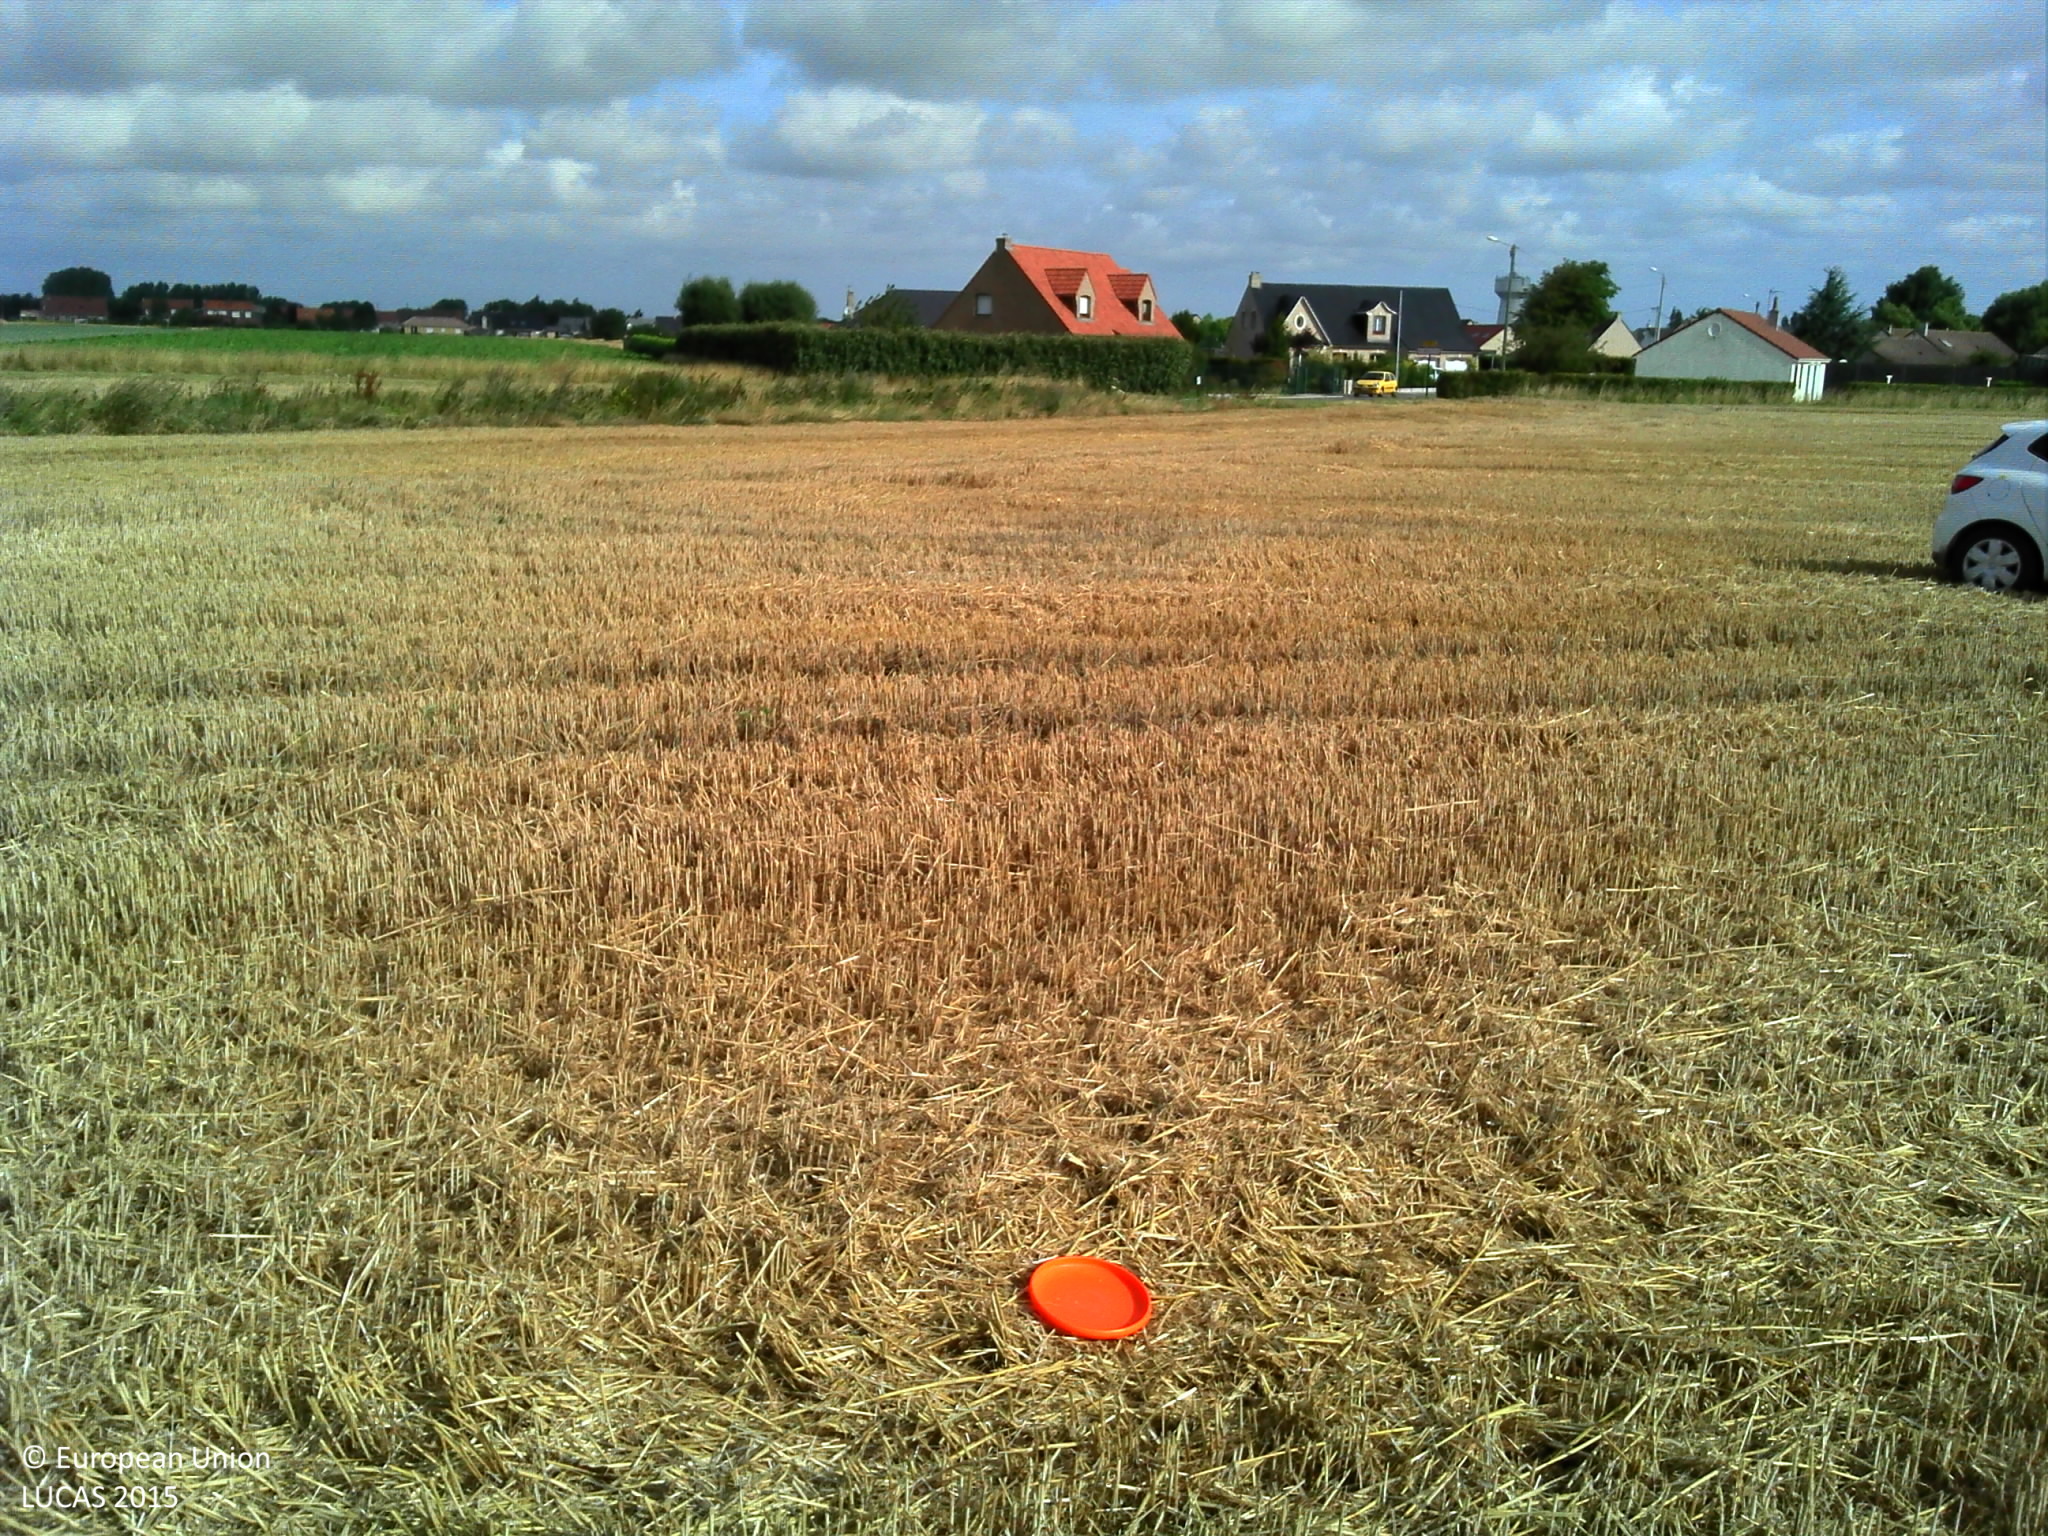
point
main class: Cropland
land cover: Common wheat
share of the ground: 50 - 75 %
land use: Agriculture (excluding fallow land and kitchen gardens)
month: August
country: FR
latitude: 50.8655
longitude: 2.0704
